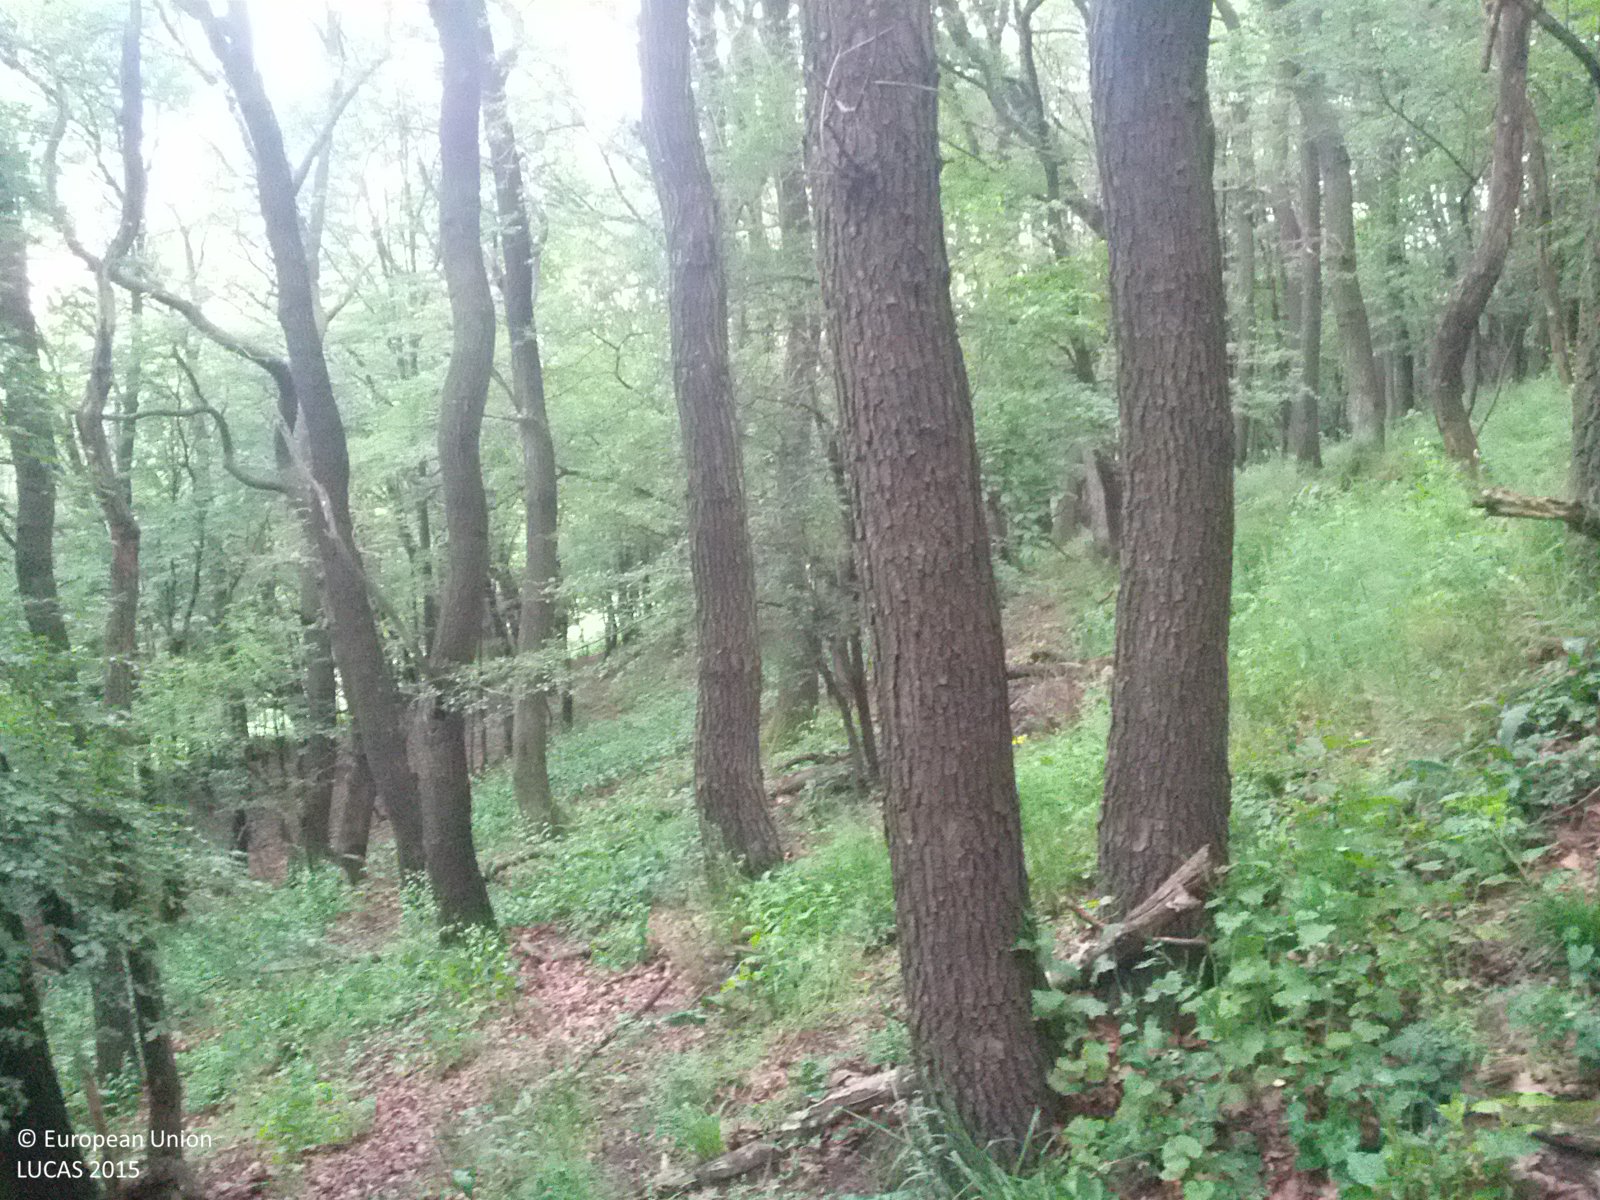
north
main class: Woodland
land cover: Broadleaved woodland
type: beech forest
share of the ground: > 75 %
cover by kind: broadleaved forest trees 90 %, herbaceous plants 10 %
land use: Forestry
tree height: > 5 m
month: May
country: AT
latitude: 48.2872
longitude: 16.1365
